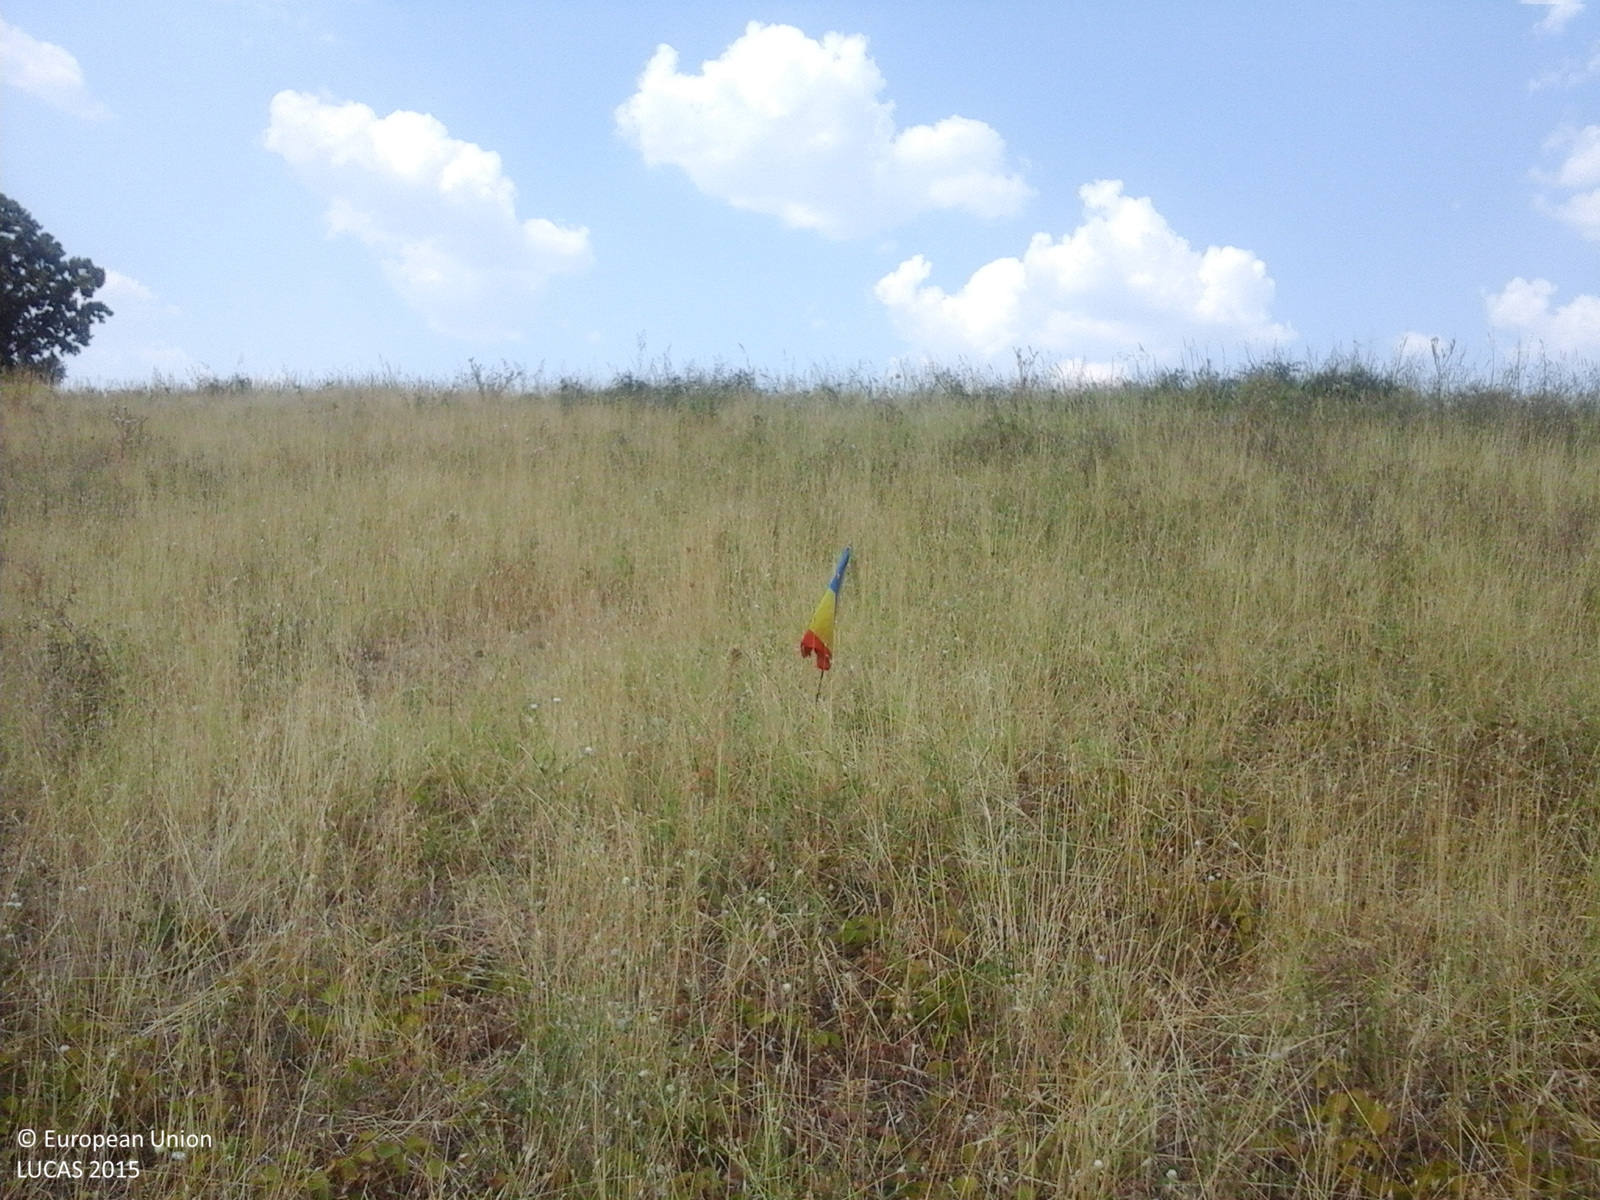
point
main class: Grassland
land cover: Spontaneously vegetated surfaces
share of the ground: > 75 %
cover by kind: herbaceous plants 100 %
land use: Fallow land
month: August
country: RO
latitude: 44.3736
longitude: 22.9577
